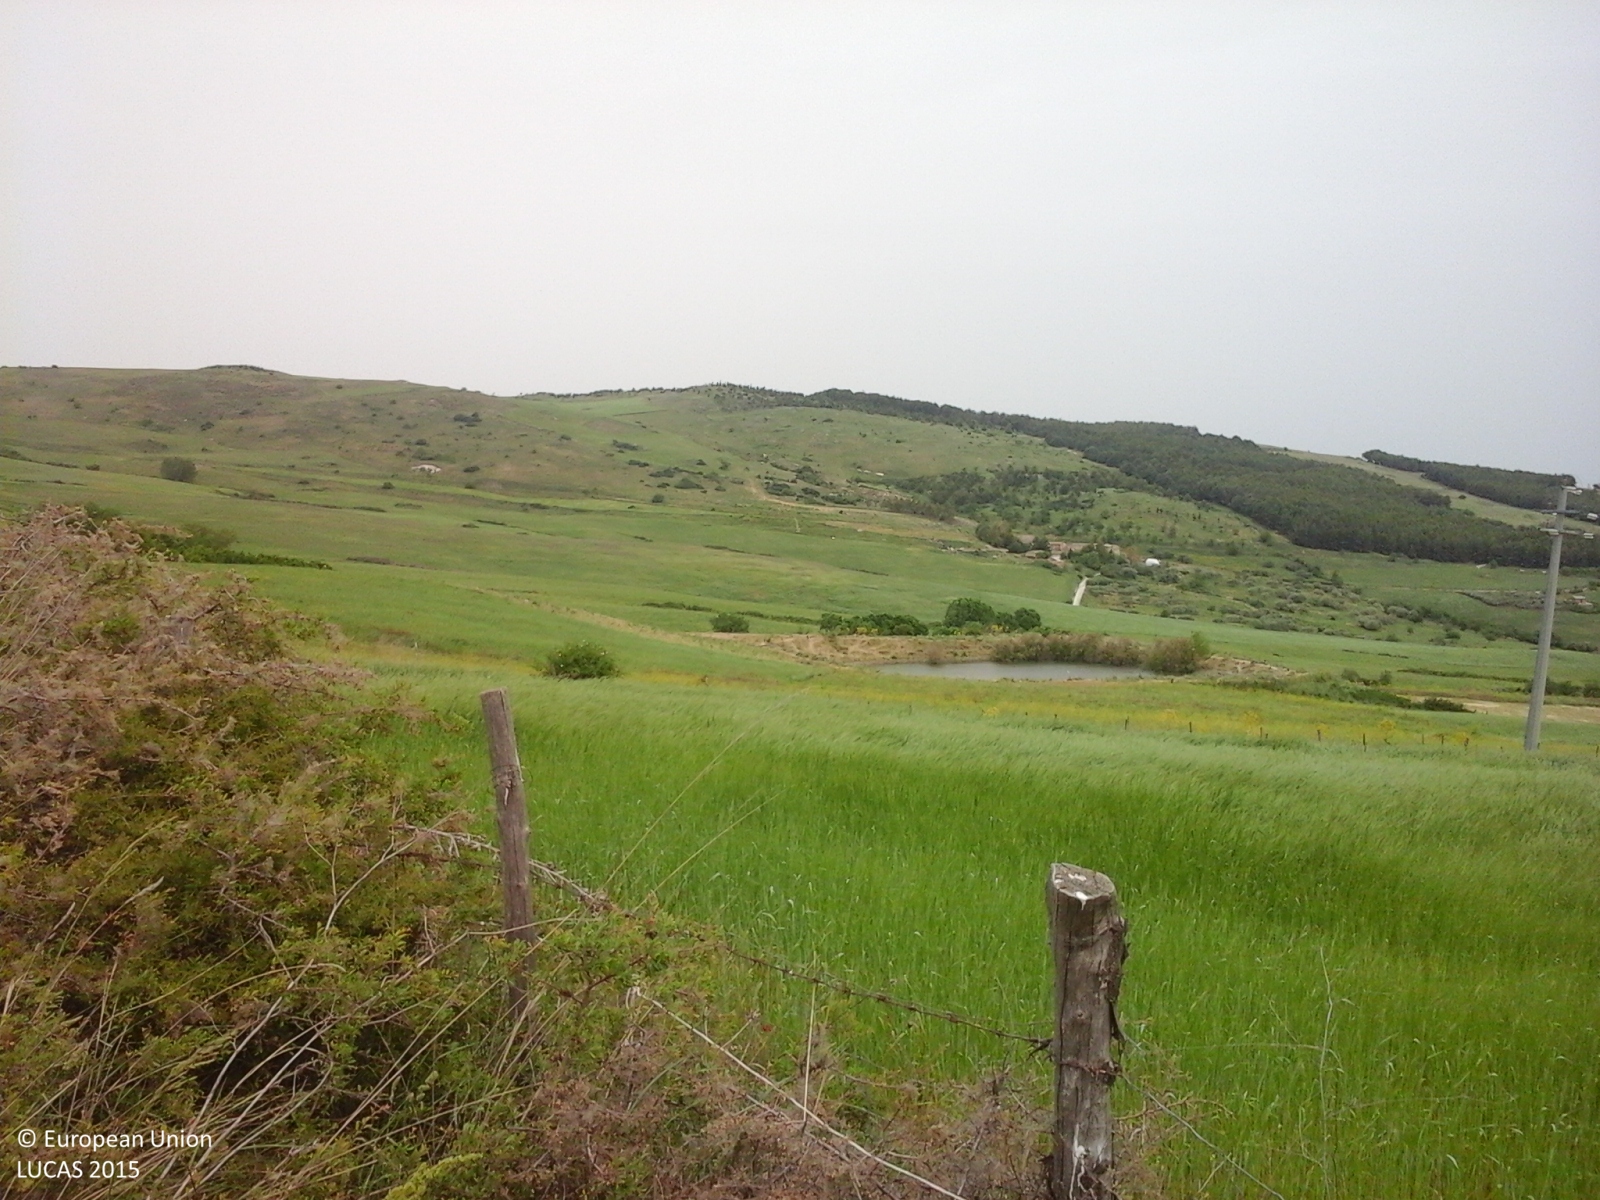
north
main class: Cropland
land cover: Durum wheat
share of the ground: > 75 %
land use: Agriculture (excluding fallow land and kitchen gardens)
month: May
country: IT
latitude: 37.7177
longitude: 13.5474
